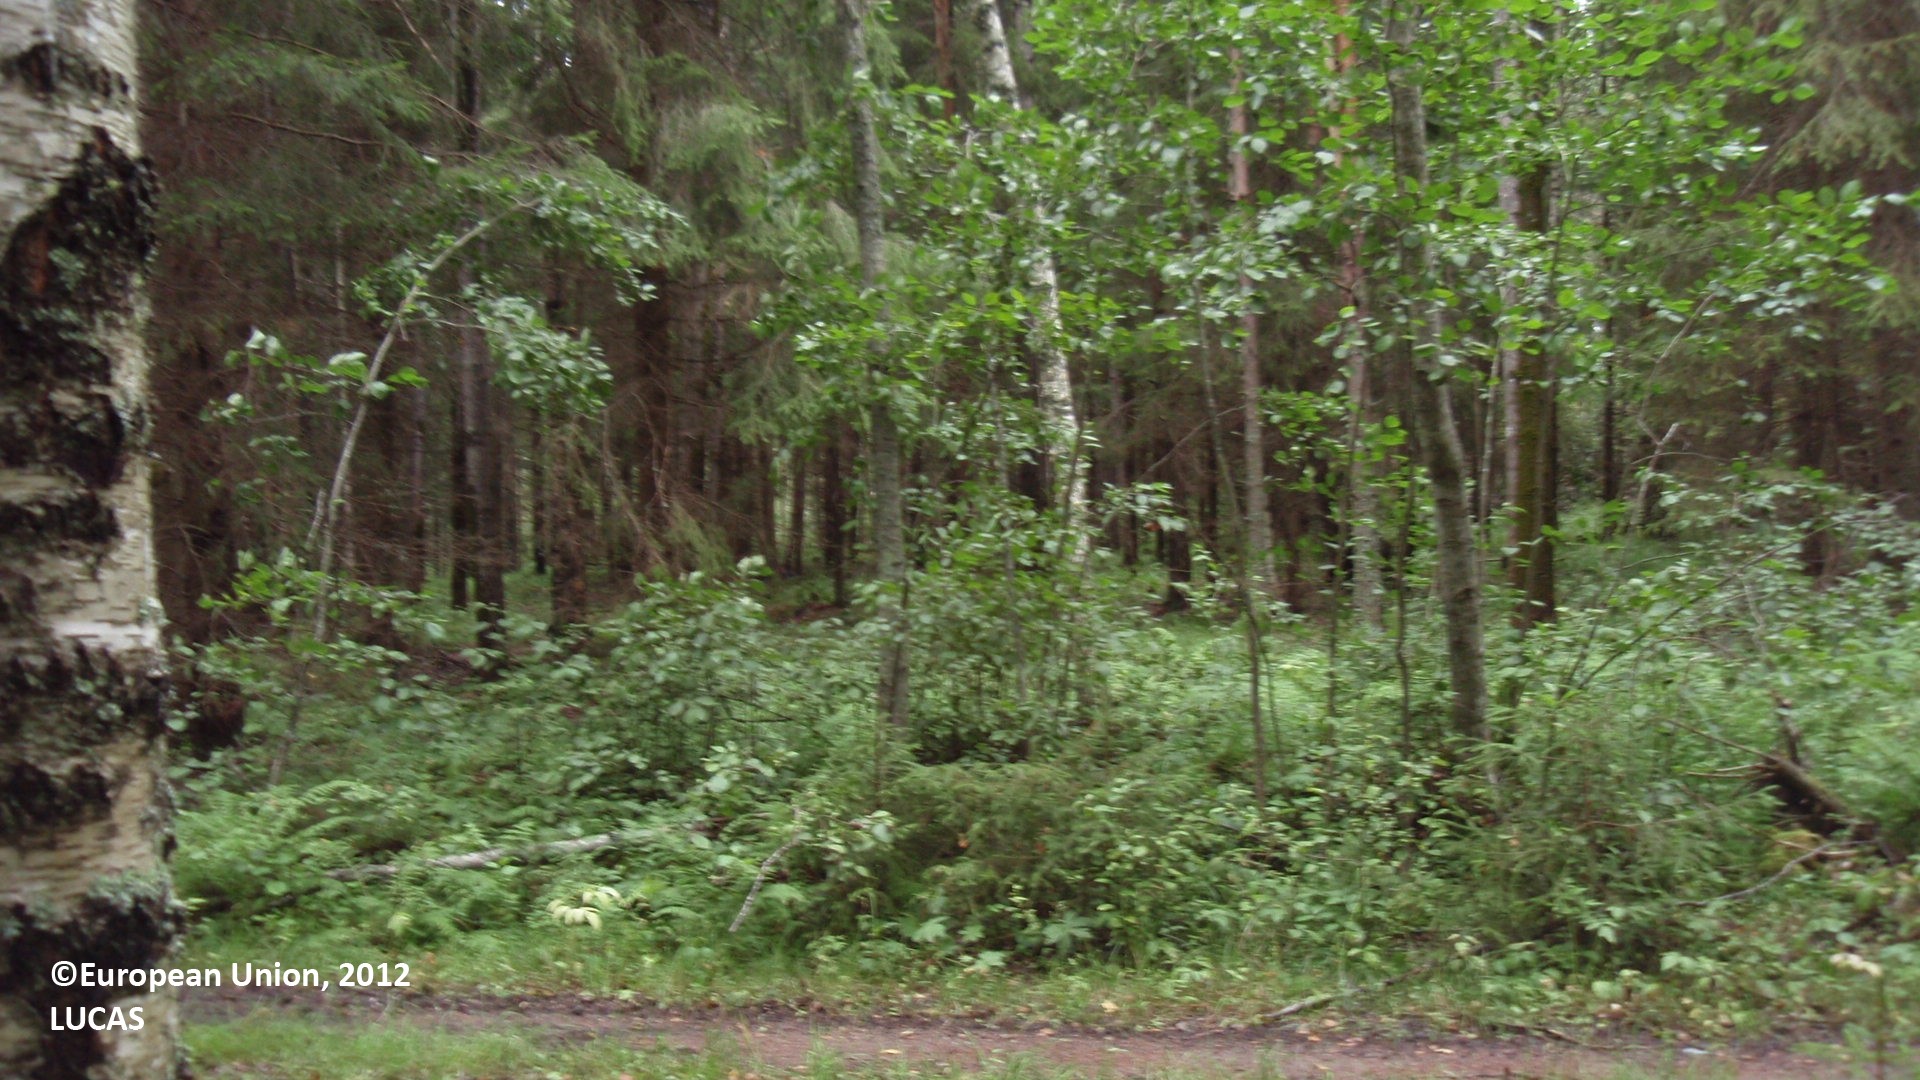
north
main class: Woodland
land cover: Spruce dominated mixed woodland
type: boreal forest
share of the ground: 50 - 75 %
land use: Forestry
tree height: > 5 m
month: August
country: FI
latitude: 61.0376
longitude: 27.3380
